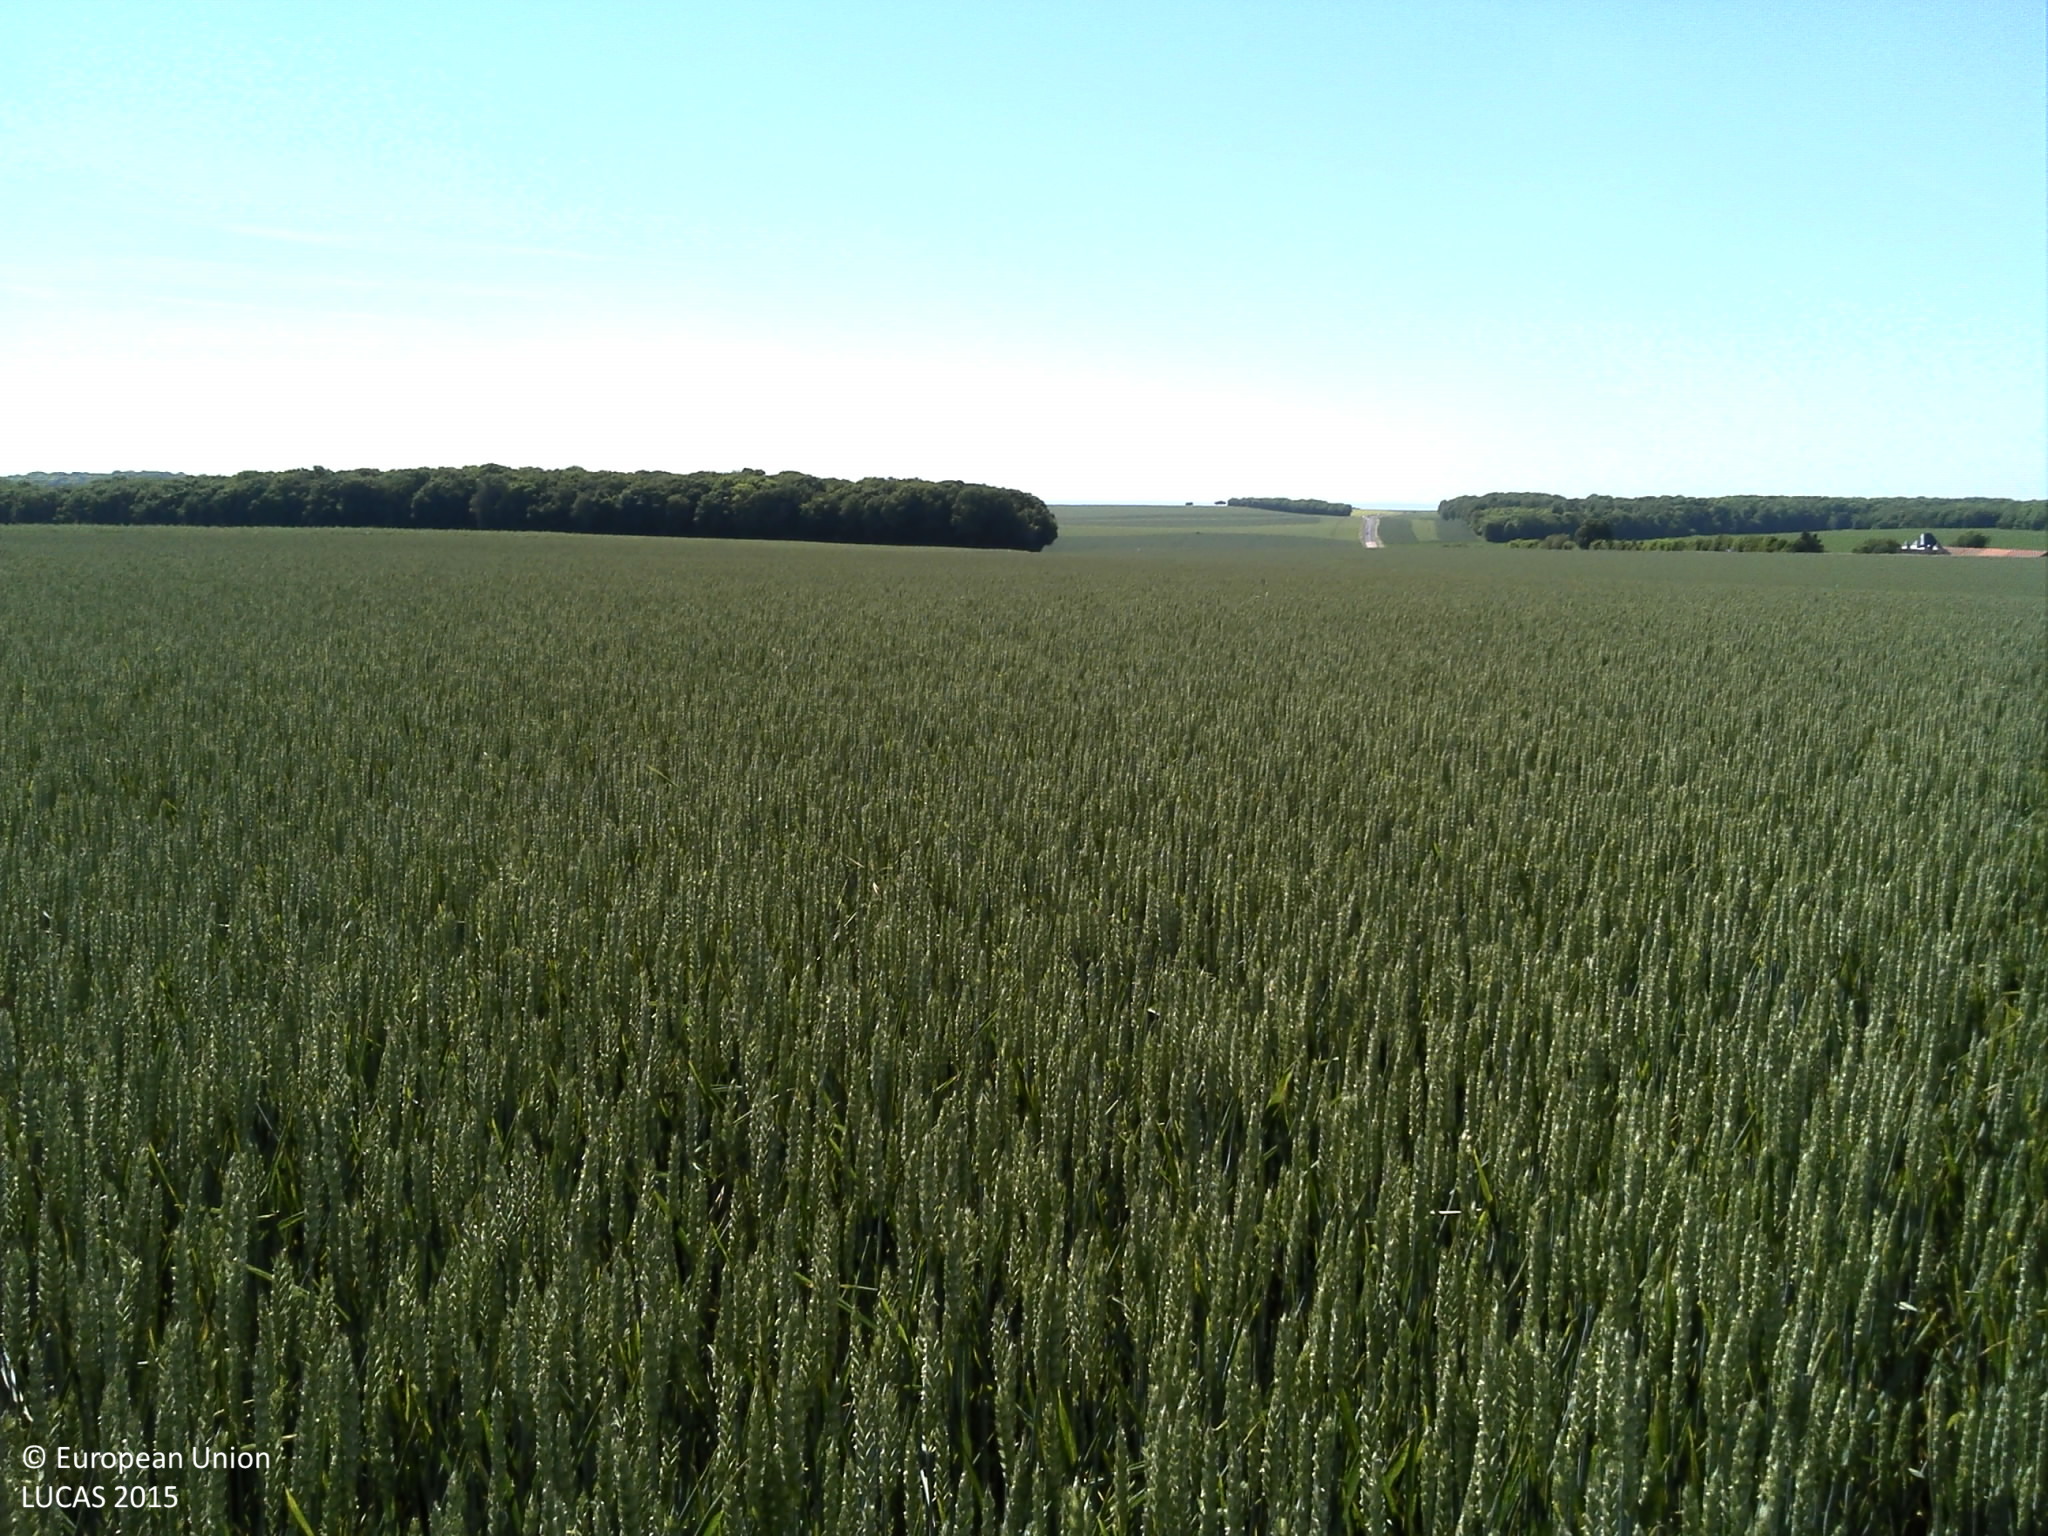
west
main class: Cropland
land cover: Common wheat
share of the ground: > 75 %
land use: Agriculture (excluding fallow land and kitchen gardens)
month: June
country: FR
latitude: 49.1241
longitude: 6.0119
